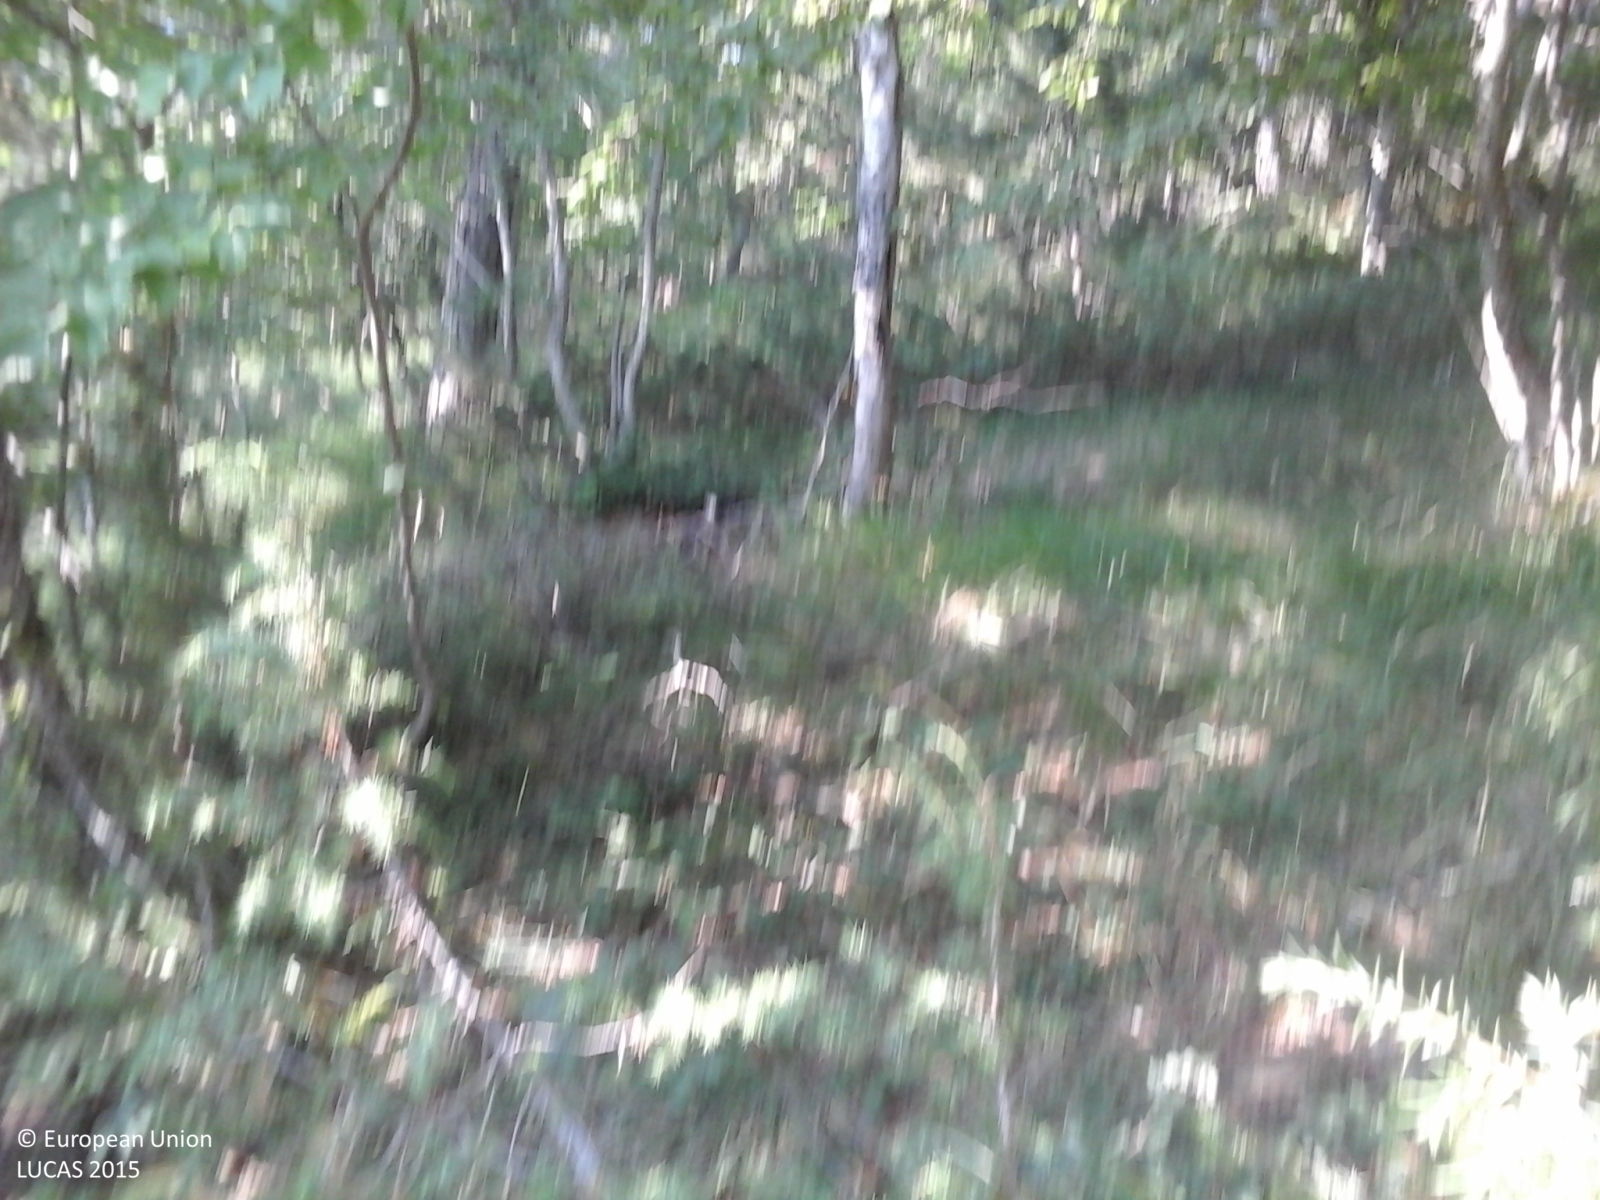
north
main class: Woodland
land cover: Pine dominated mixed woodland
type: coniferous forest of the mediterranean region
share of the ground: > 75 %
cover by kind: coniferous forest trees 75 %, broadleaved forest trees 25 %
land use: Forestry
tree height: > 5 m
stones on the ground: < 10 %
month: August
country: IT
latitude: 42.9118
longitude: 13.1634
